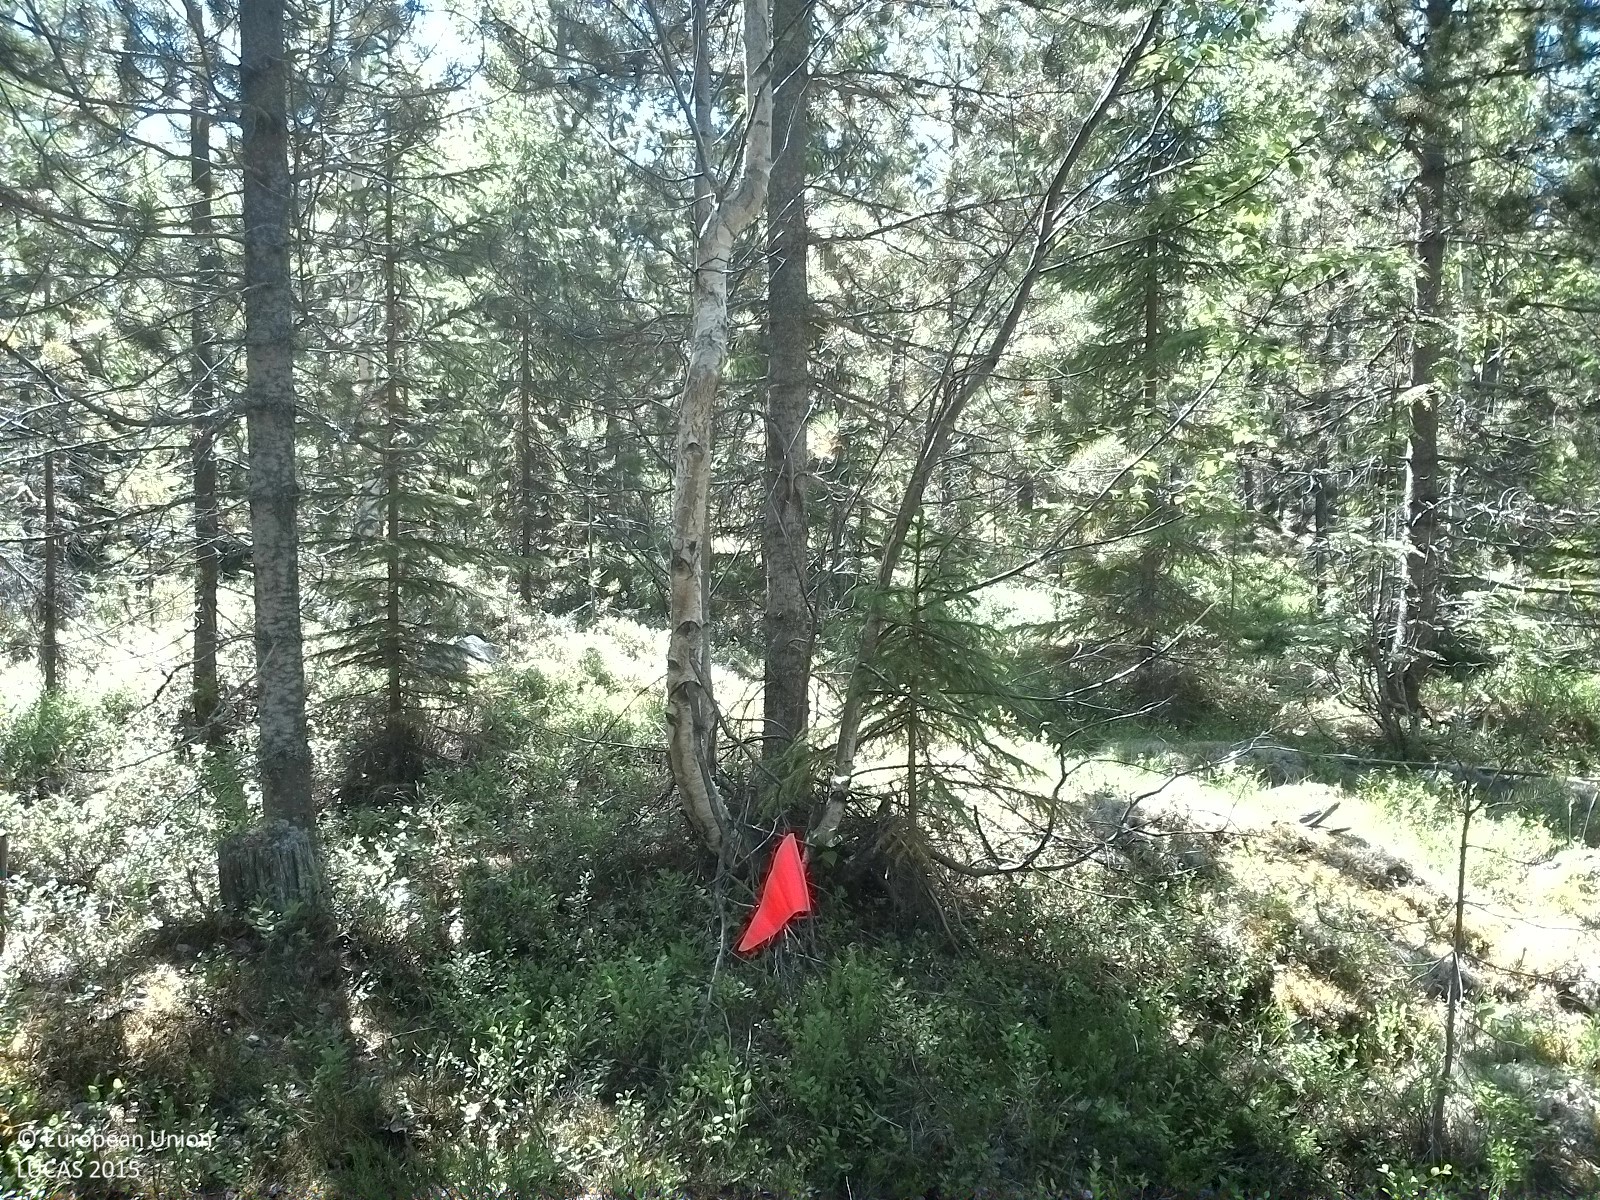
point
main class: Woodland
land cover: Pine dominated coniferous woodland
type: exotic forest
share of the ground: 25 - 50 %
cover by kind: shrubs 50 %, coniferous forest trees 40 %, broadleaved forest trees 5 %, lichens and mosses 5 %
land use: Forestry
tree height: > 5 m
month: July
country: SE
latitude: 62.2500
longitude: 17.0077
